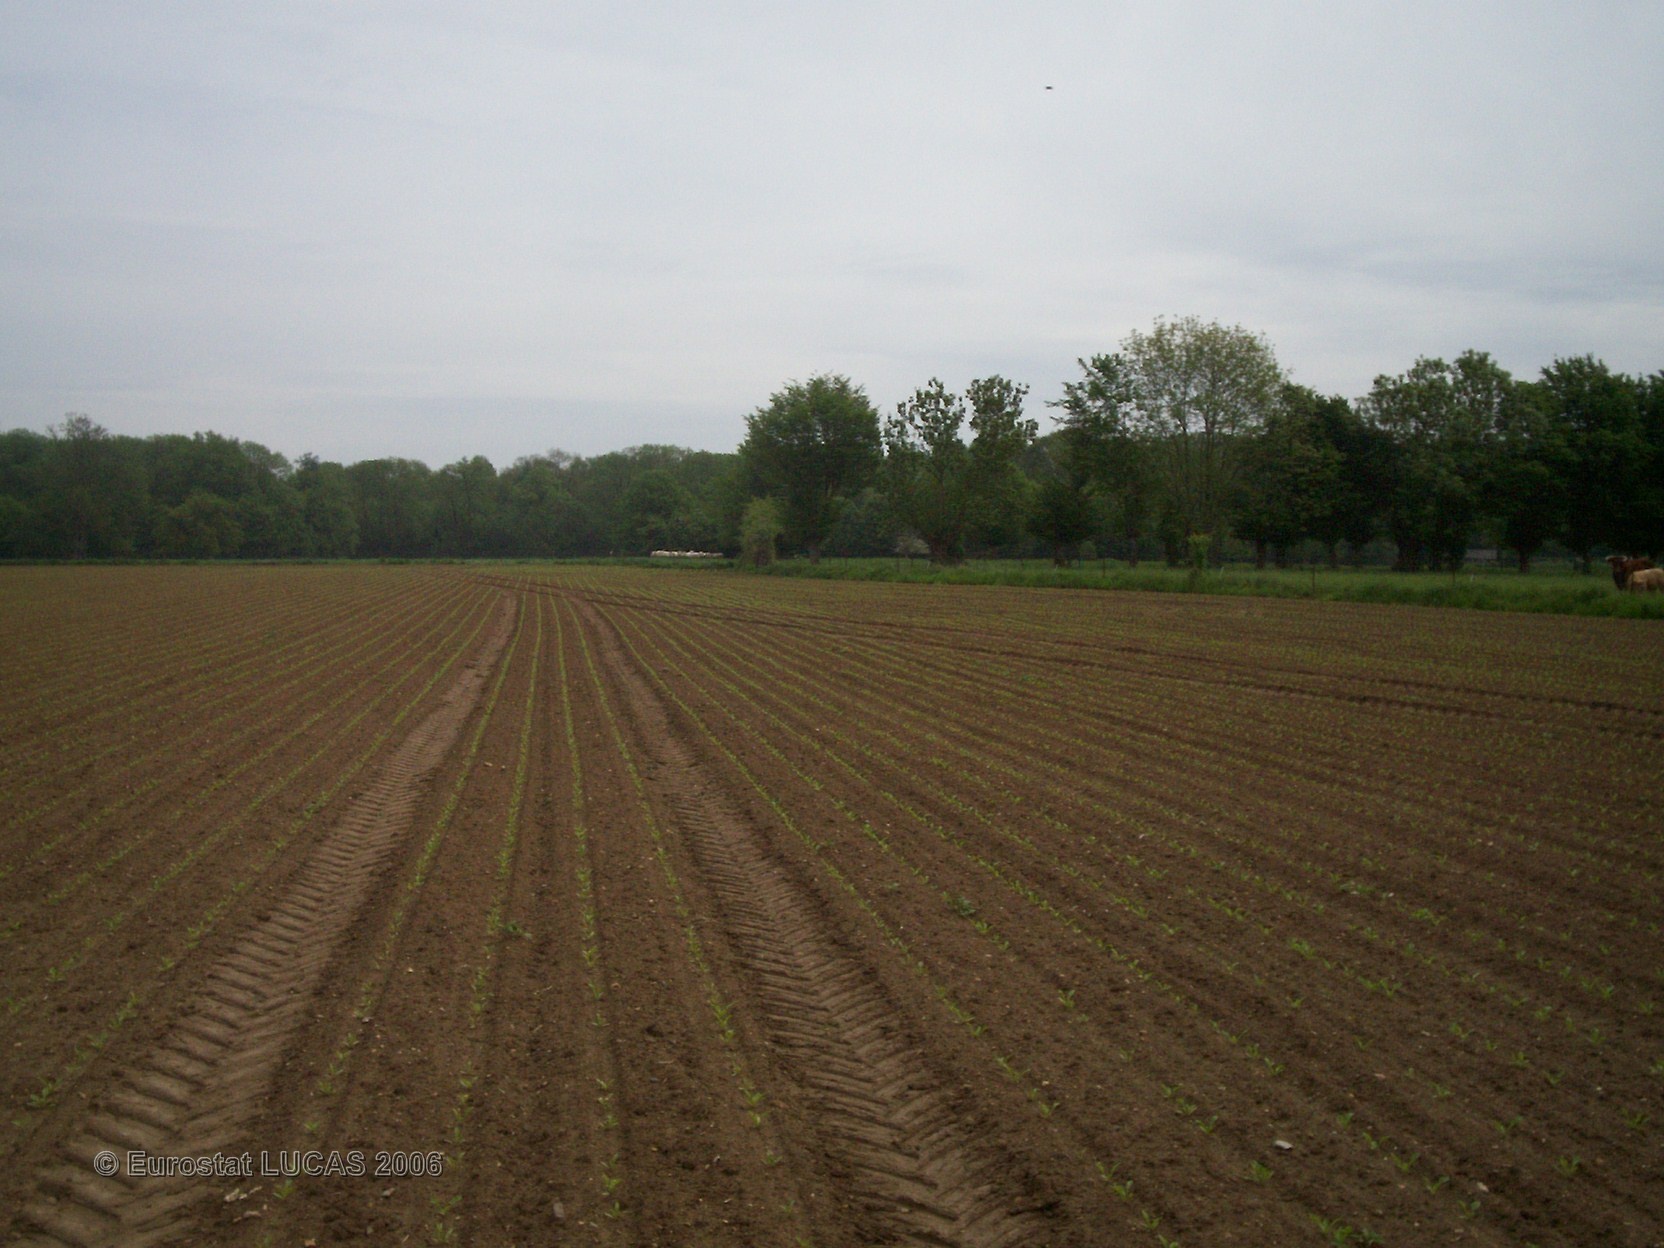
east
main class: Cropland
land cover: Sugar beet
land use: Agriculture (excluding fallow land and kitchen gardens)
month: May
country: FR
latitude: 49.9399
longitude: 3.7372
